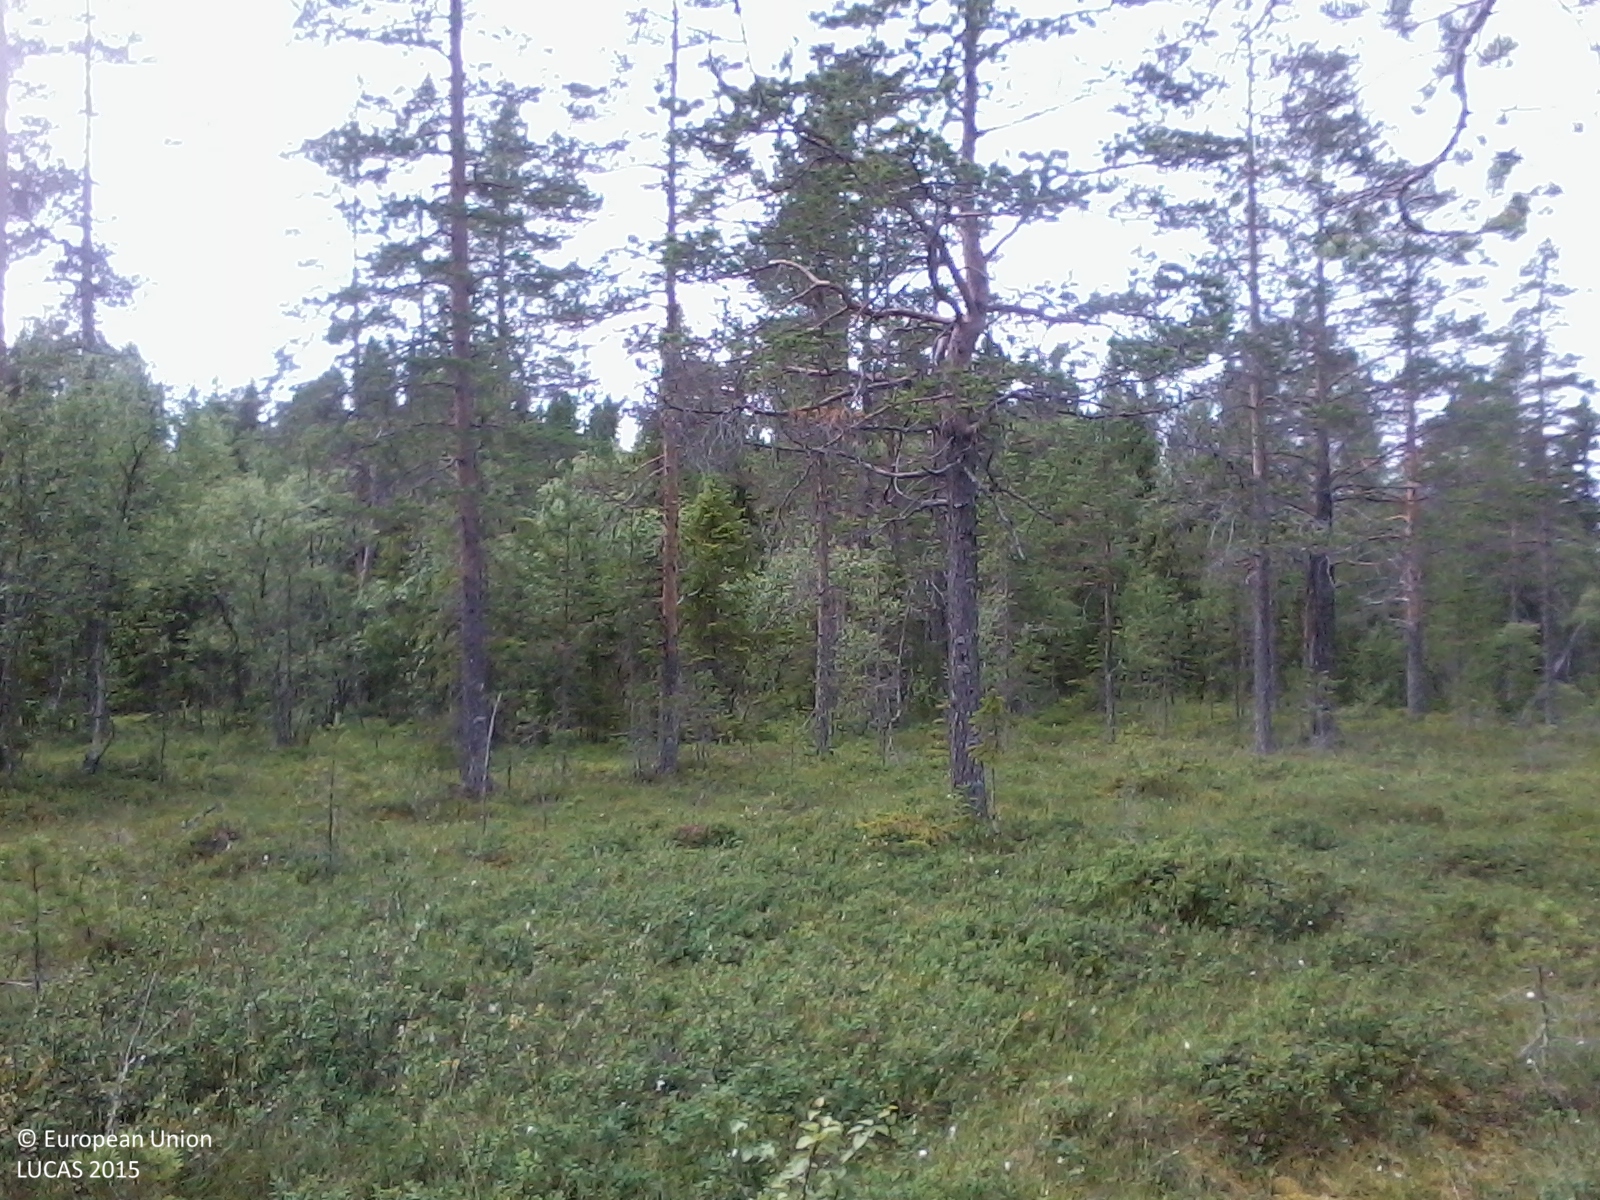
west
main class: Woodland
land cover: Pine dominated coniferous woodland
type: boreal forest
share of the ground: 10 - 25 %
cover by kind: shrubs 60 %, coniferous forest trees 20 %, herbaceous plants 15 %, lichens and mosses 5 %
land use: Forestry
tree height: > 5 m
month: August
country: SE
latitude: 62.8789
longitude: 17.1148
